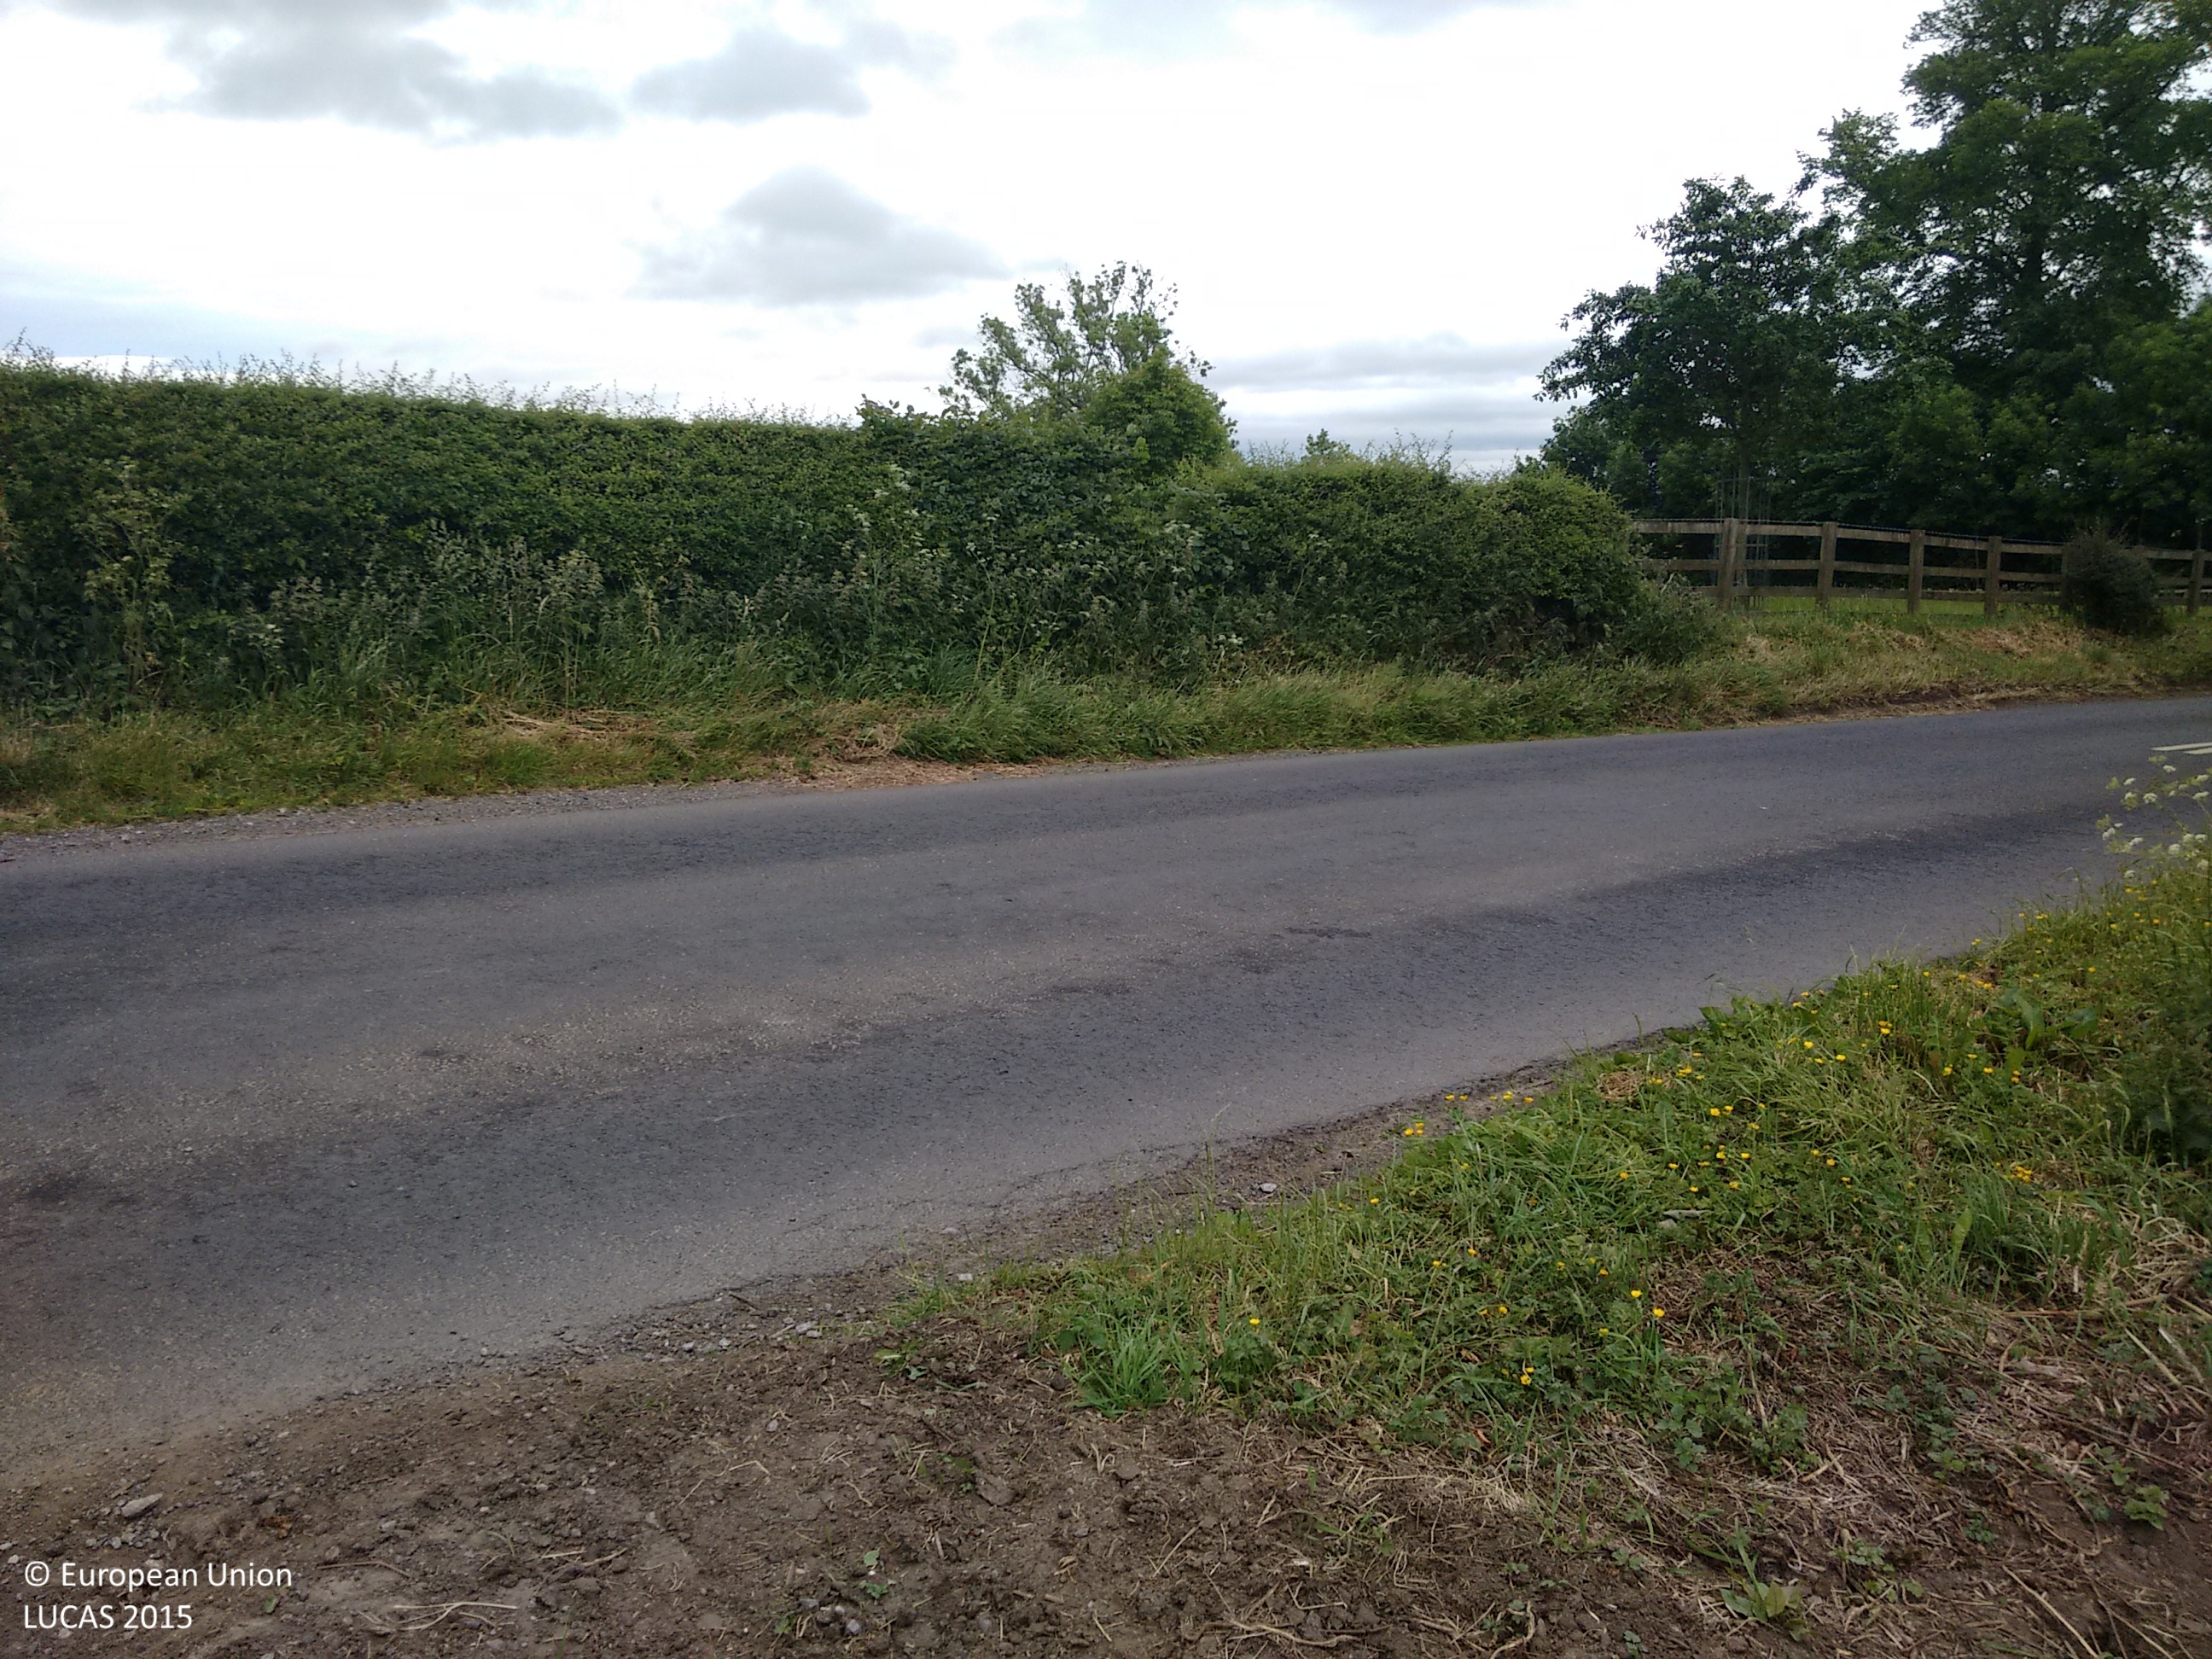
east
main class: Grassland
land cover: Grassland without tree/shrub cover
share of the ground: > 75 %
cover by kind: herbaceous plants 100 %
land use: Agriculture (excluding fallow land and kitchen gardens)
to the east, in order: Grassland without tree/shrub cover; Managed hedges; Grass margins; Paved roads, cycling and walking lanes; Grass margins; Managed hedges; Paved roads, cycling and walking lanes; Lines of trees; Grassland with sparse tree/shrub cover; Grassland without tree/shrub cover; Single bushes/trees; Grassland without tree/shrub cover
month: June
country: GB
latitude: 54.3474
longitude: -1.6349
